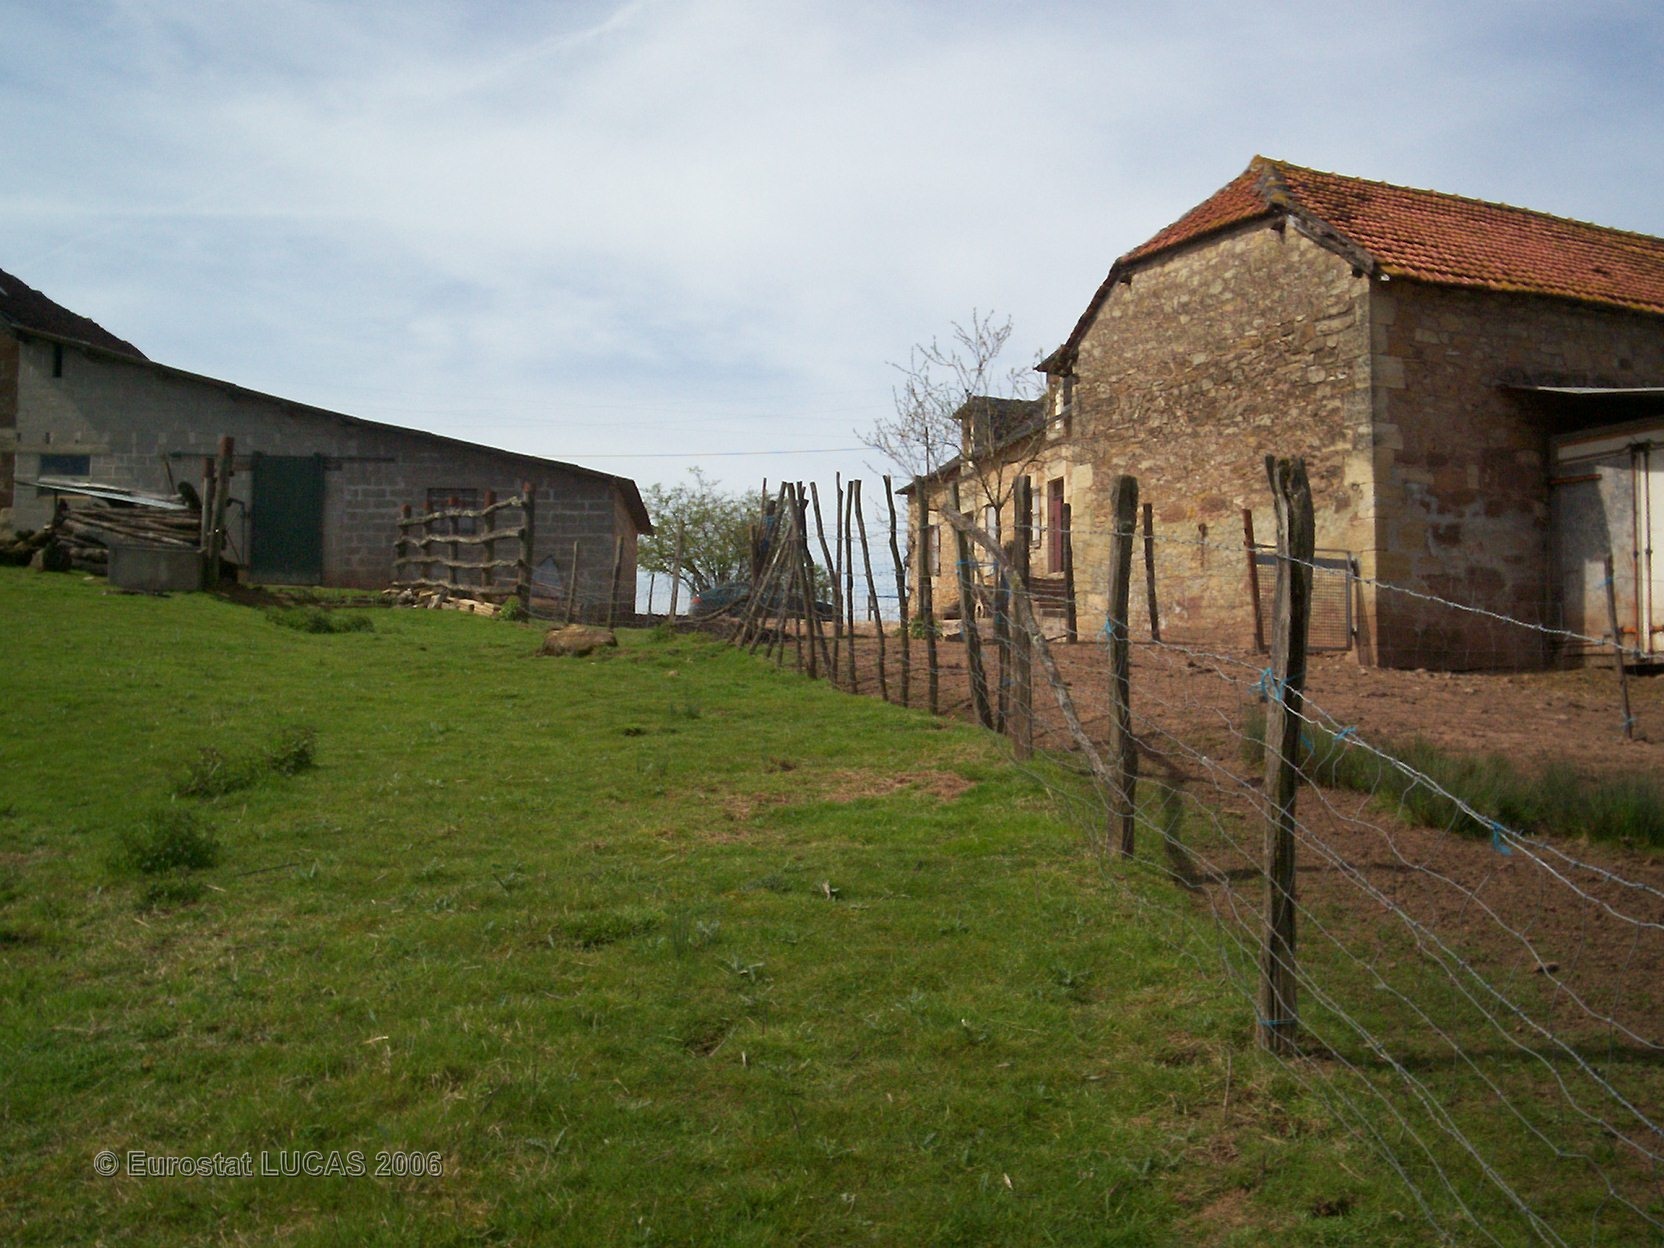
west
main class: Grassland
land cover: Grassland without tree/shrub cover
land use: Agriculture (excluding fallow land and kitchen gardens)
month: April
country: FR
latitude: 45.2169
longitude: 1.2964
